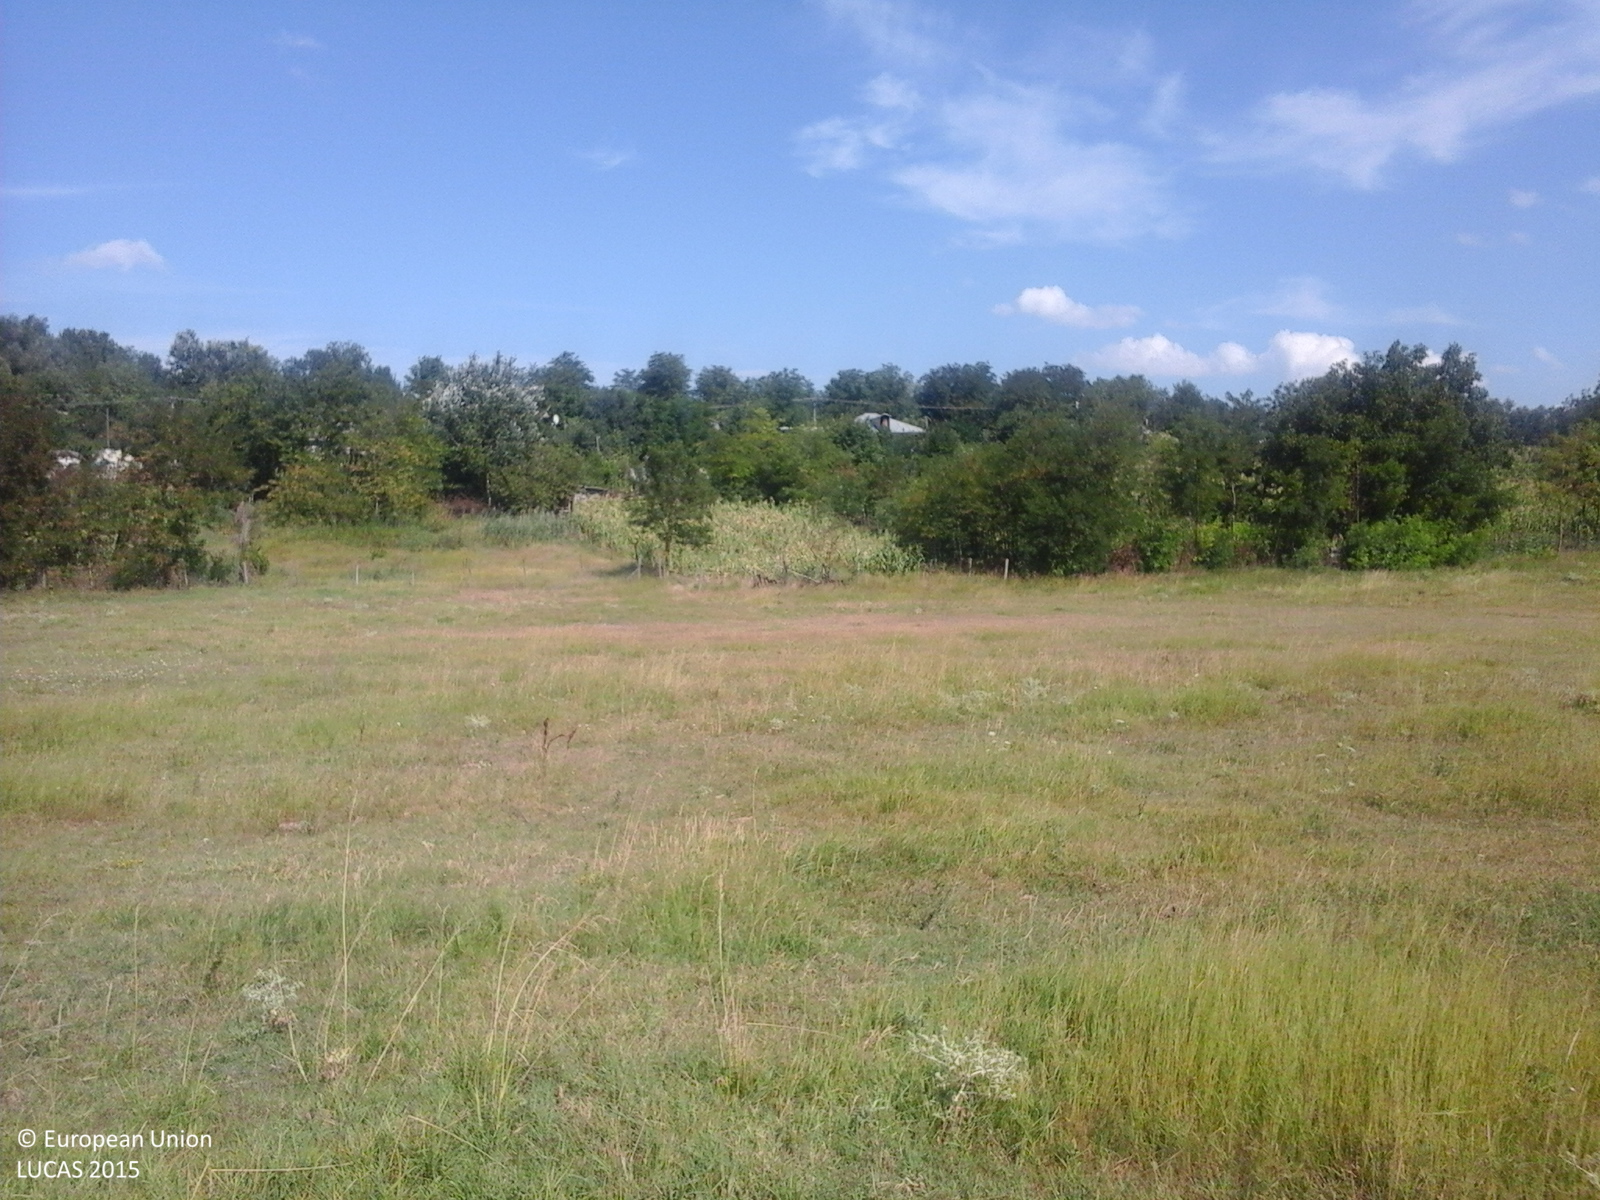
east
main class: Grassland
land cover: Grassland without tree/shrub cover
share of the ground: > 75 %
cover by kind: herbaceous plants 100 %
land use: Agriculture (excluding fallow land and kitchen gardens)
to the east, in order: Grassland without tree/shrub cover; Fences; Grassland without tree/shrub cover; Maize; Abandoned hedges; Arable land (only in case pi); Abandoned hedges; Artificial constructions in urban areas; Arable land (only in case pi)
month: July
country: RO
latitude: 46.4963
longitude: 27.8278
